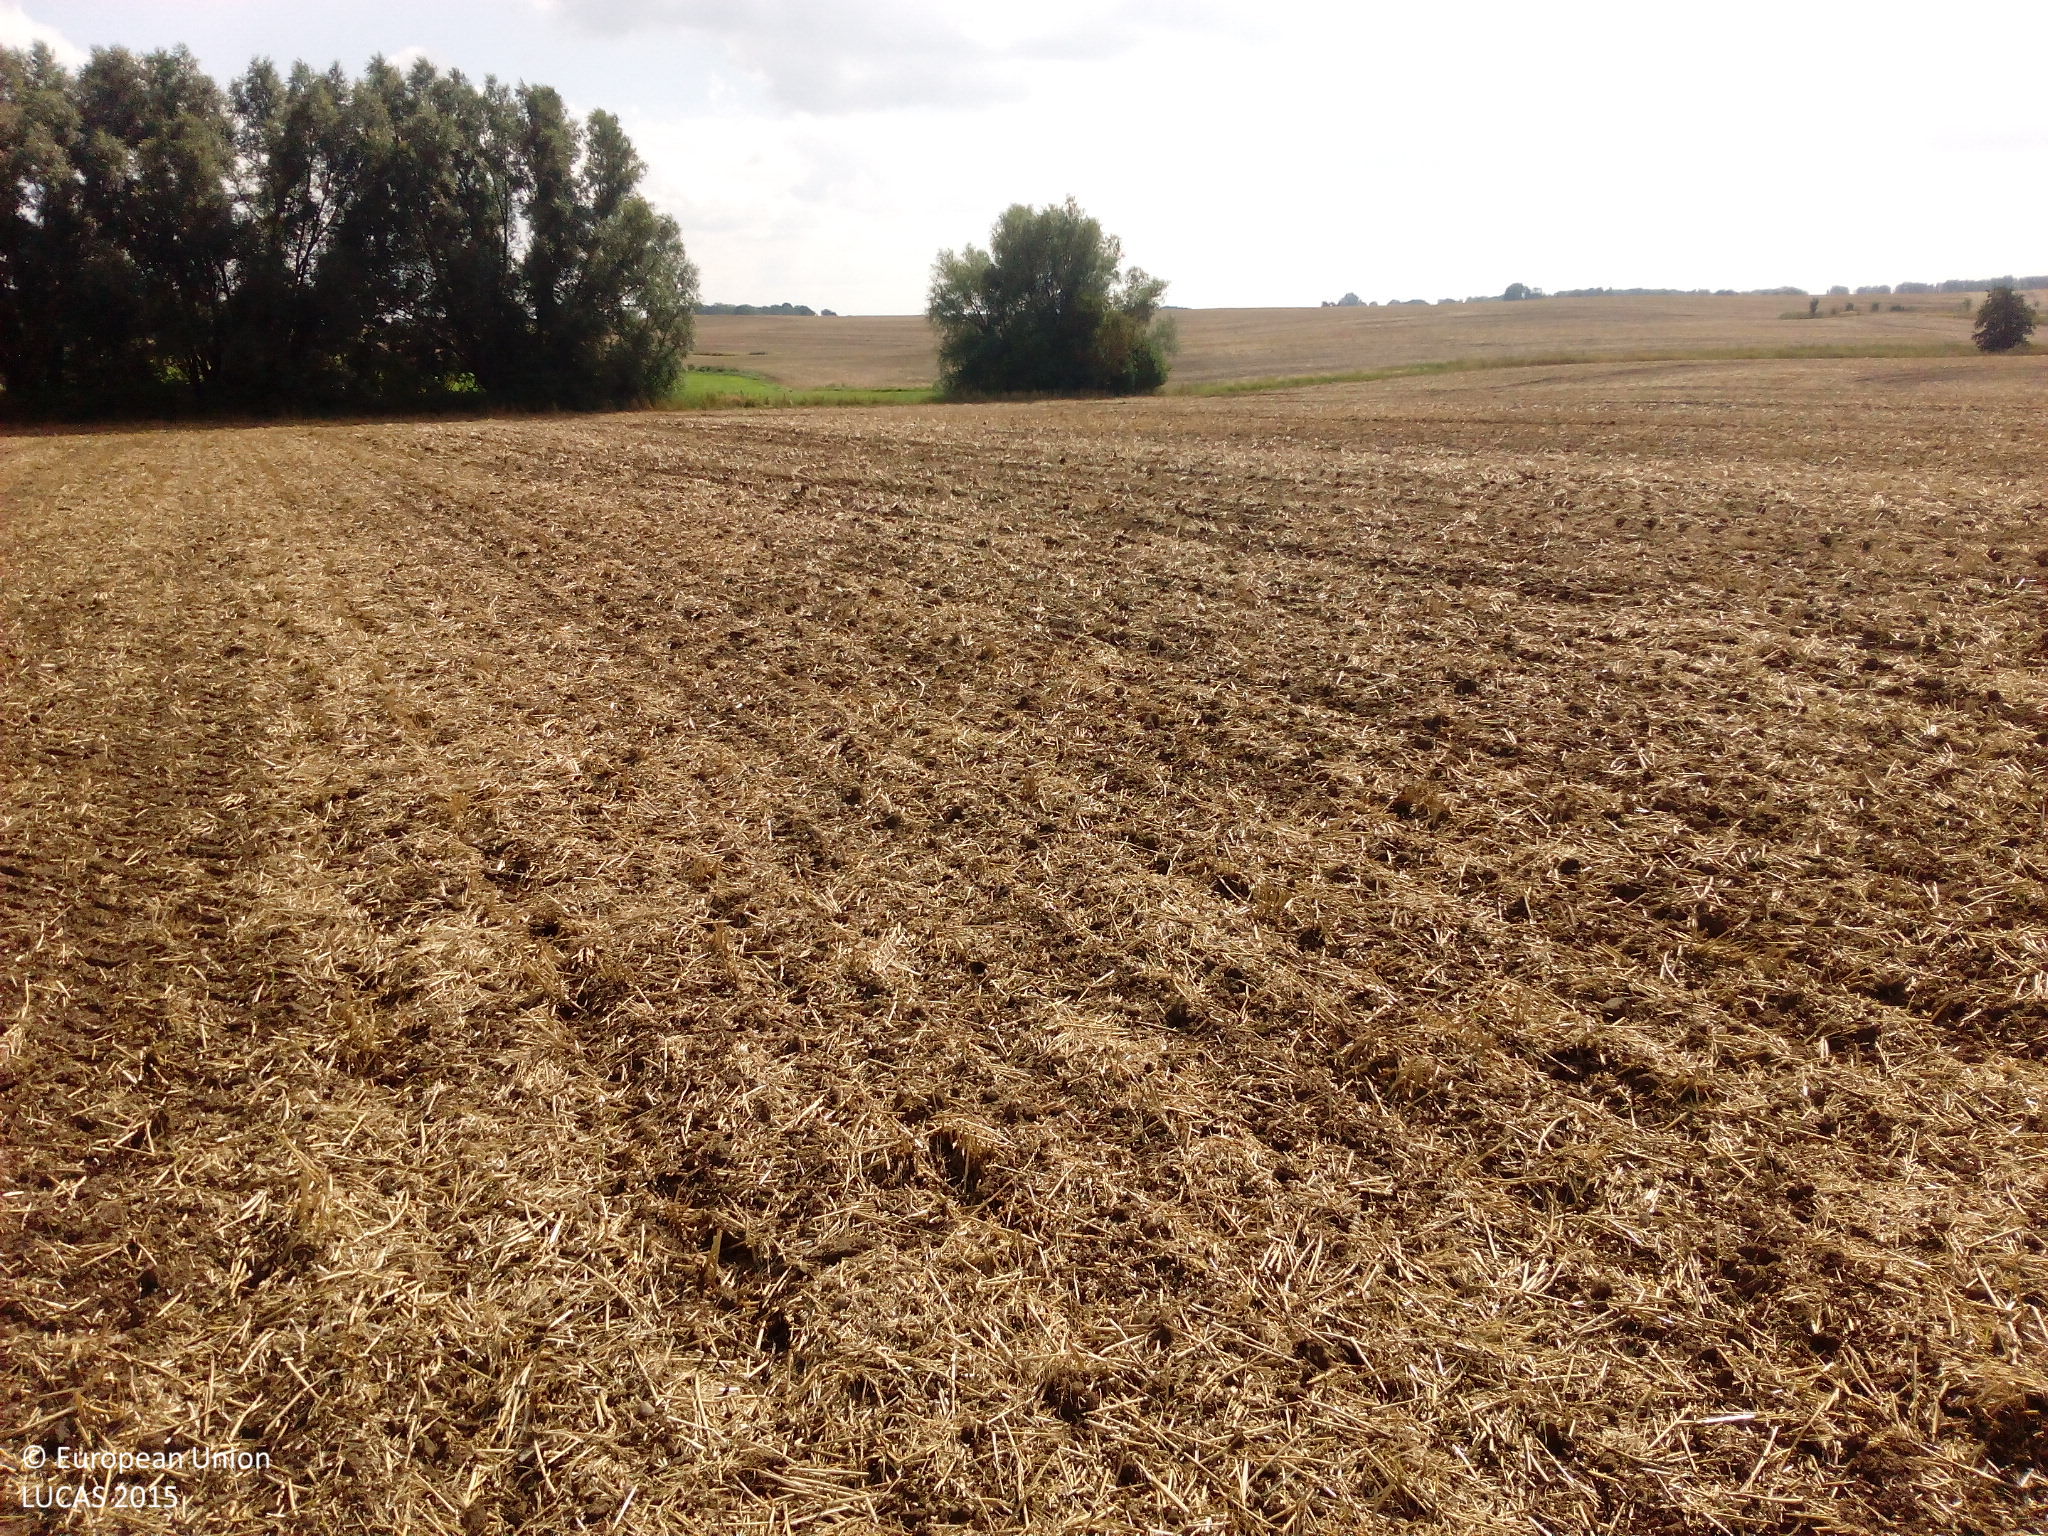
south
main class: Cropland
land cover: Common wheat
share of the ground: 25 - 50 %
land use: Agriculture (excluding fallow land and kitchen gardens)
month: August
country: DE
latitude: 54.0392
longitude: 12.6103
